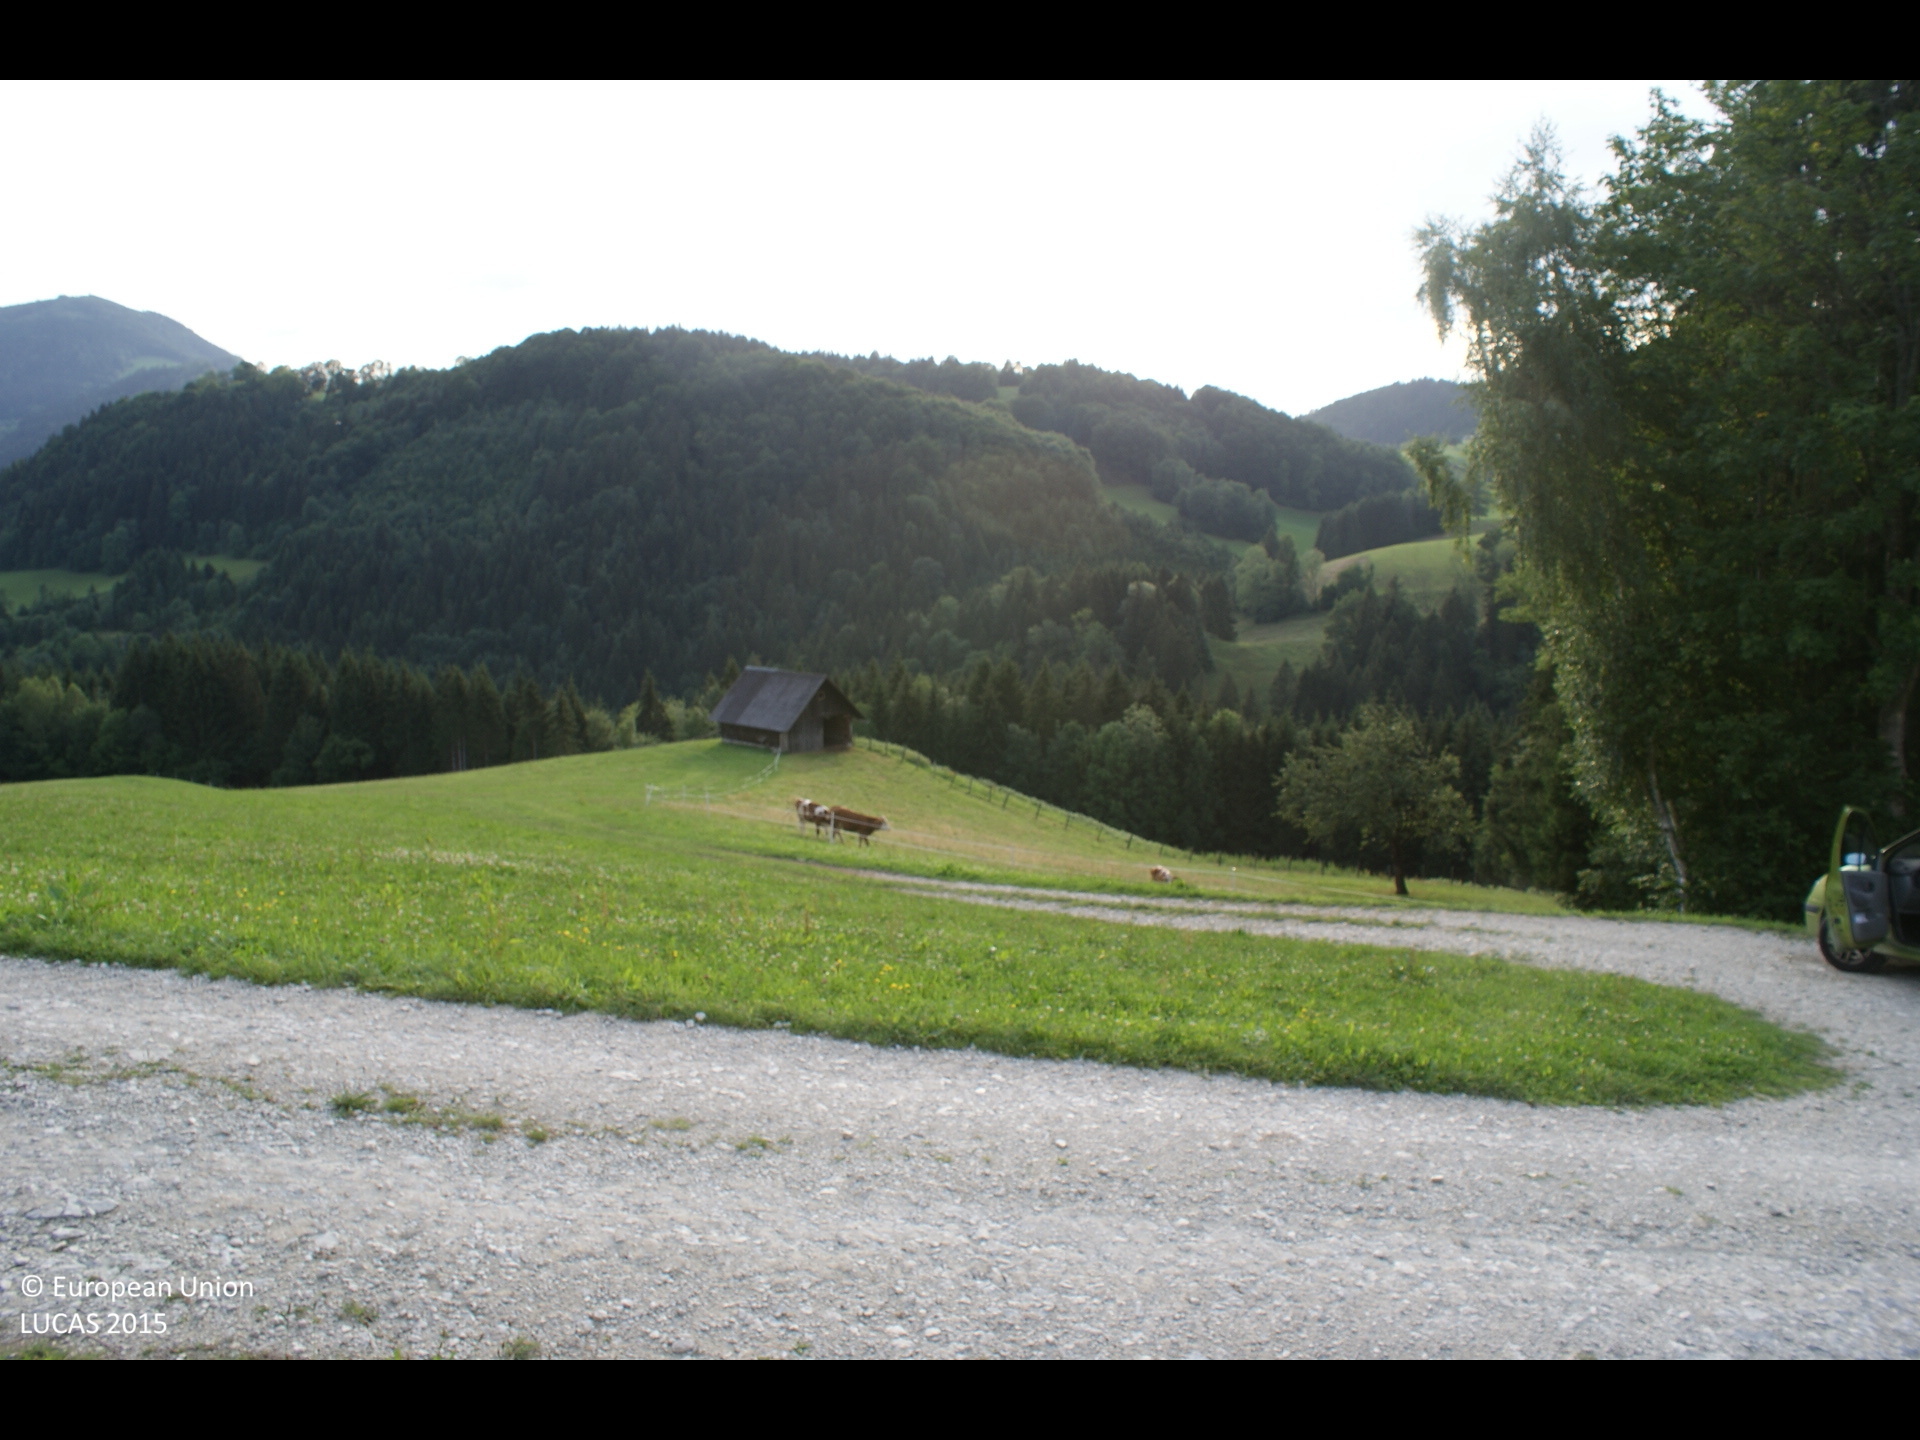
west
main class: Grassland
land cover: Grassland without tree/shrub cover
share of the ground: > 75 %
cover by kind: herbaceous plants 100 %
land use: Agriculture (excluding fallow land and kitchen gardens)
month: July
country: AT
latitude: 47.9493
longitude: 14.9682
